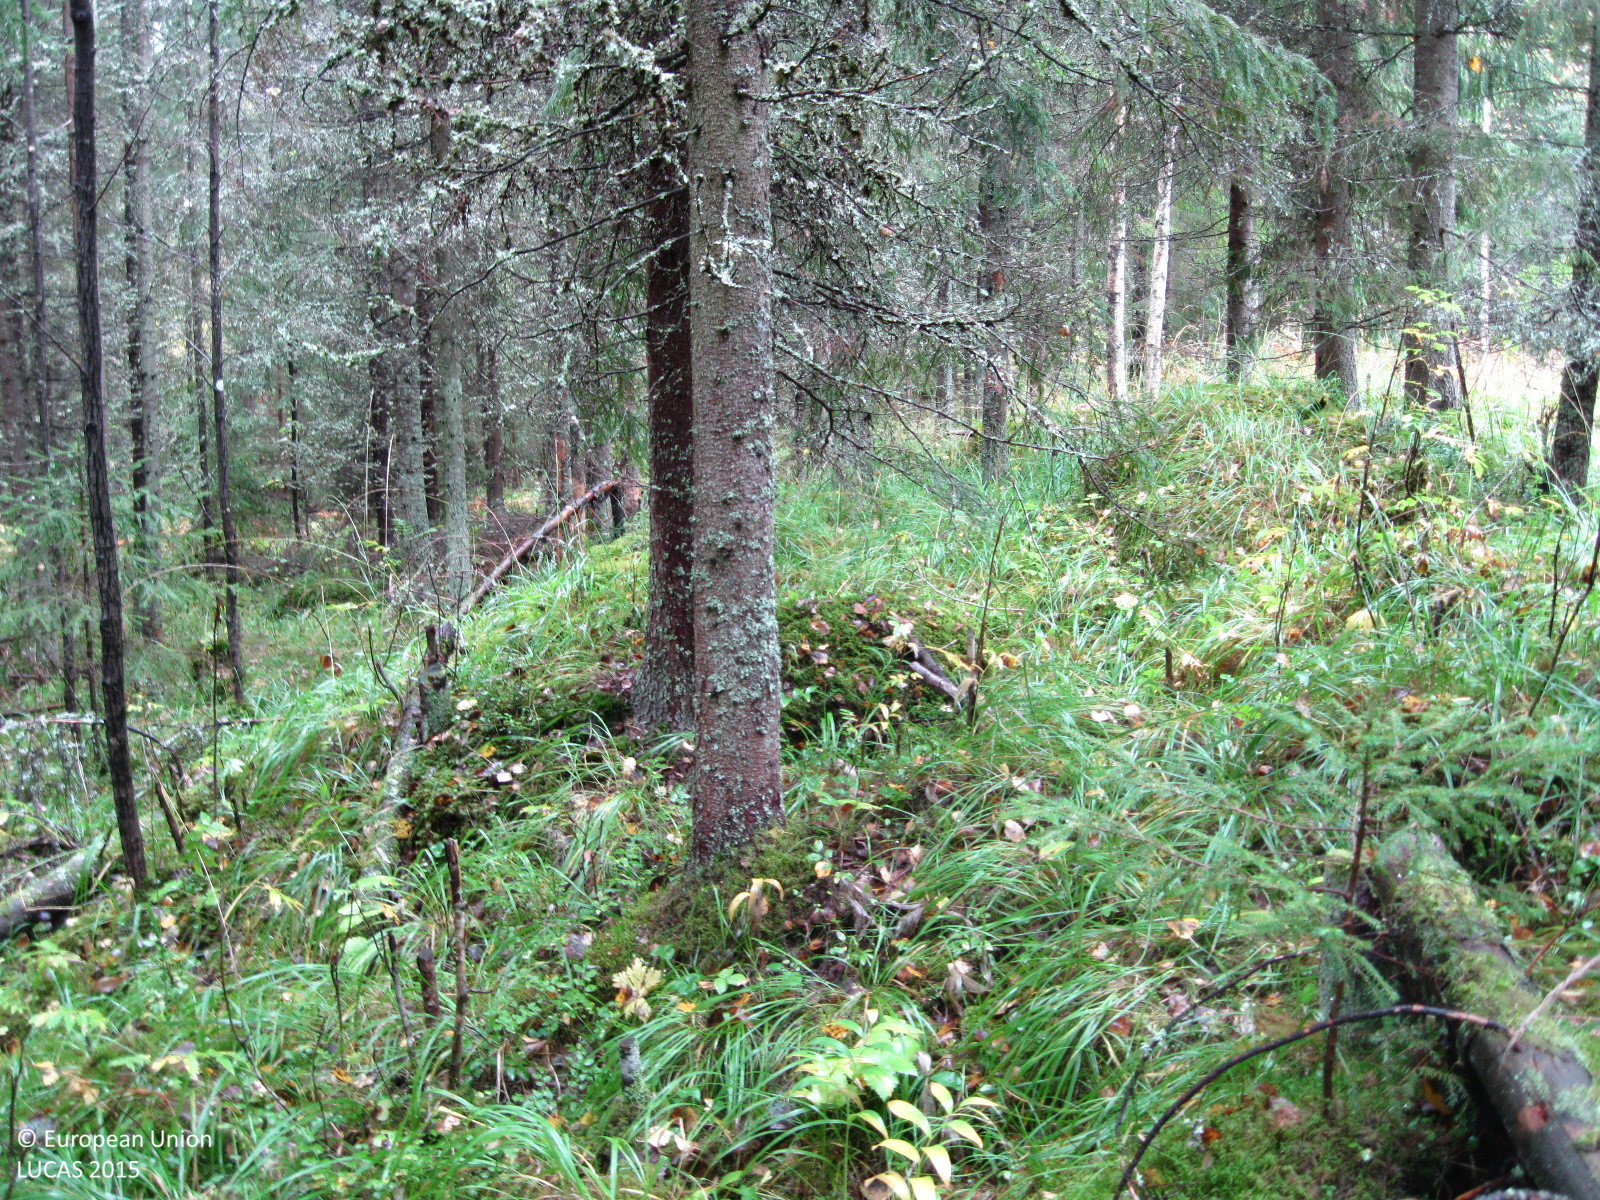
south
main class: Woodland
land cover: Spruce dominated coniferous woodland
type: boreal forest
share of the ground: 50 - 75 %
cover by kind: coniferous forest trees 60 %, herbaceous plants 15 %, broadleaved forest trees 10 %, lichens and mosses 10 %, shrubs 5 %
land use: Forestry
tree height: > 5 m
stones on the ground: > 50 %
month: September
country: FI
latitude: 60.7485
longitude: 24.8438
